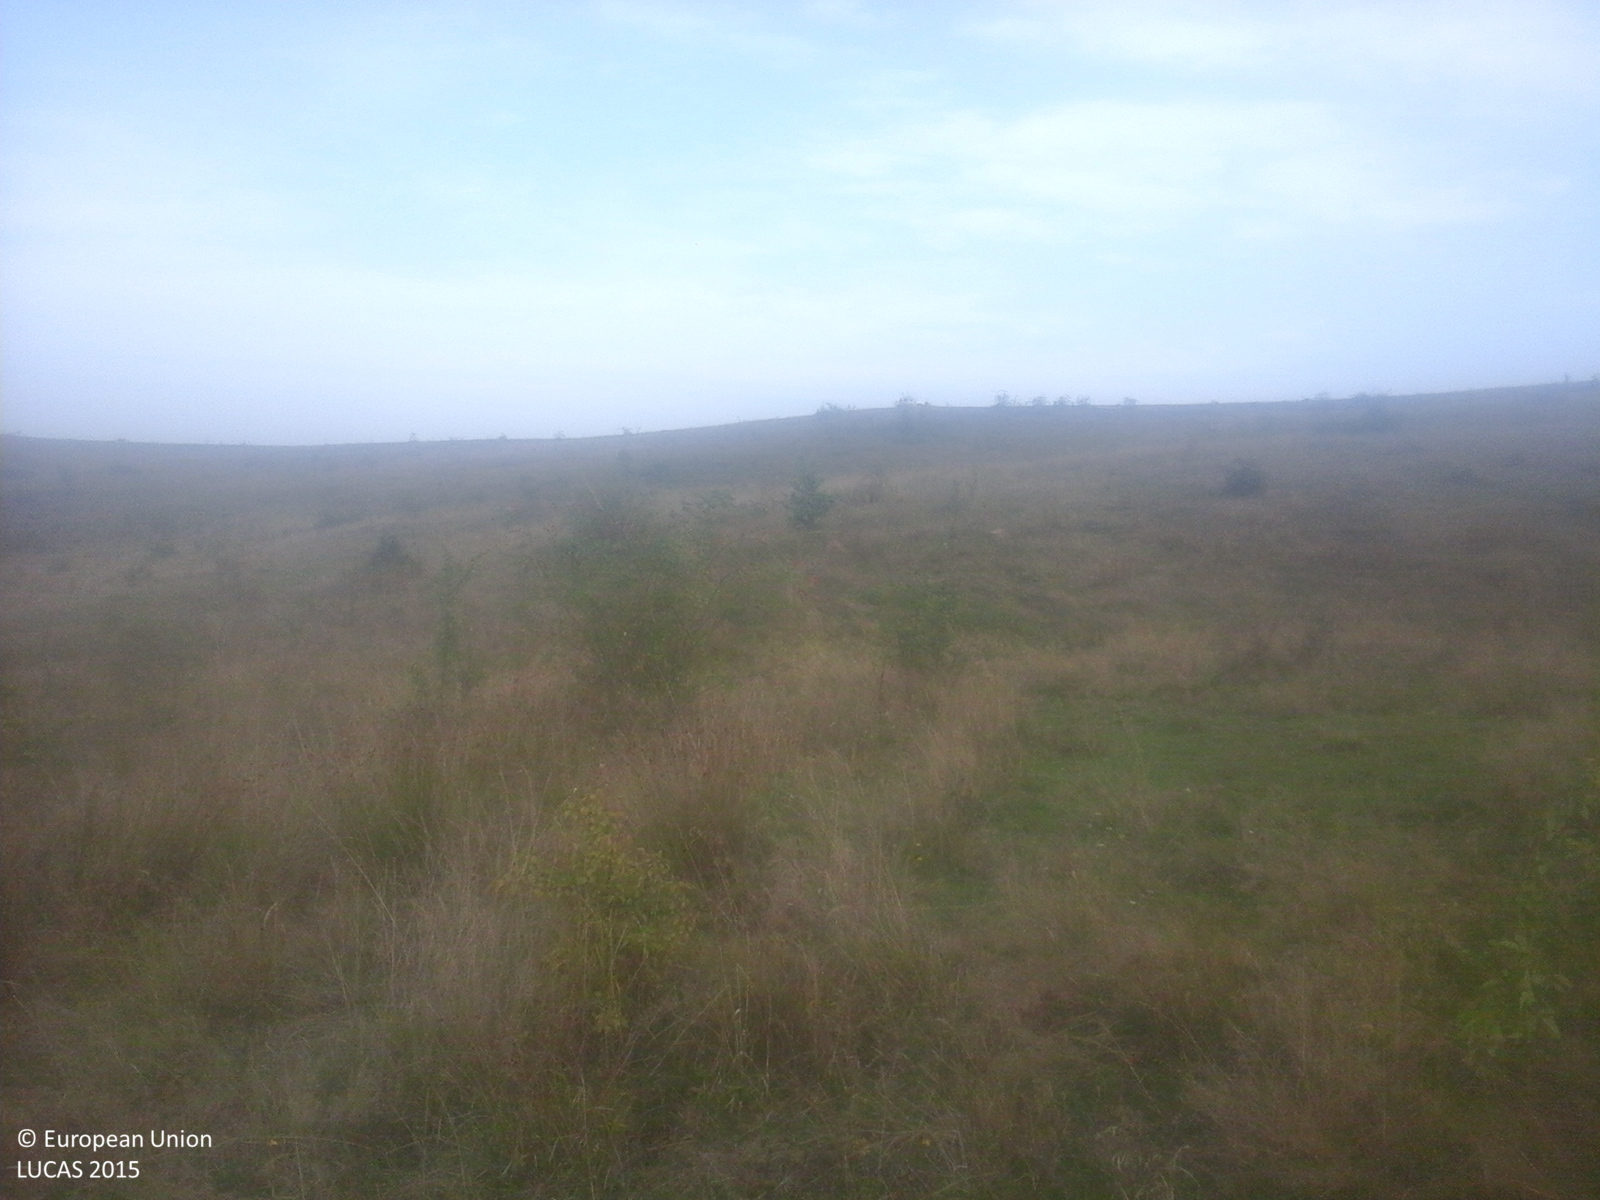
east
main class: Shrubland
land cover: Shrubland without tree cover
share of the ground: > 75 %
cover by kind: shrubs 60 %, herbaceous plants 40 %
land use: Agriculture (excluding fallow land and kitchen gardens)
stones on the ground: < 10 %
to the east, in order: Shrubland without tree cover; Tracks; Grassland without tree/shrub cover; Tracks; Grassland without tree/shrub cover
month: September
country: RO
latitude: 47.0328
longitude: 23.1317
